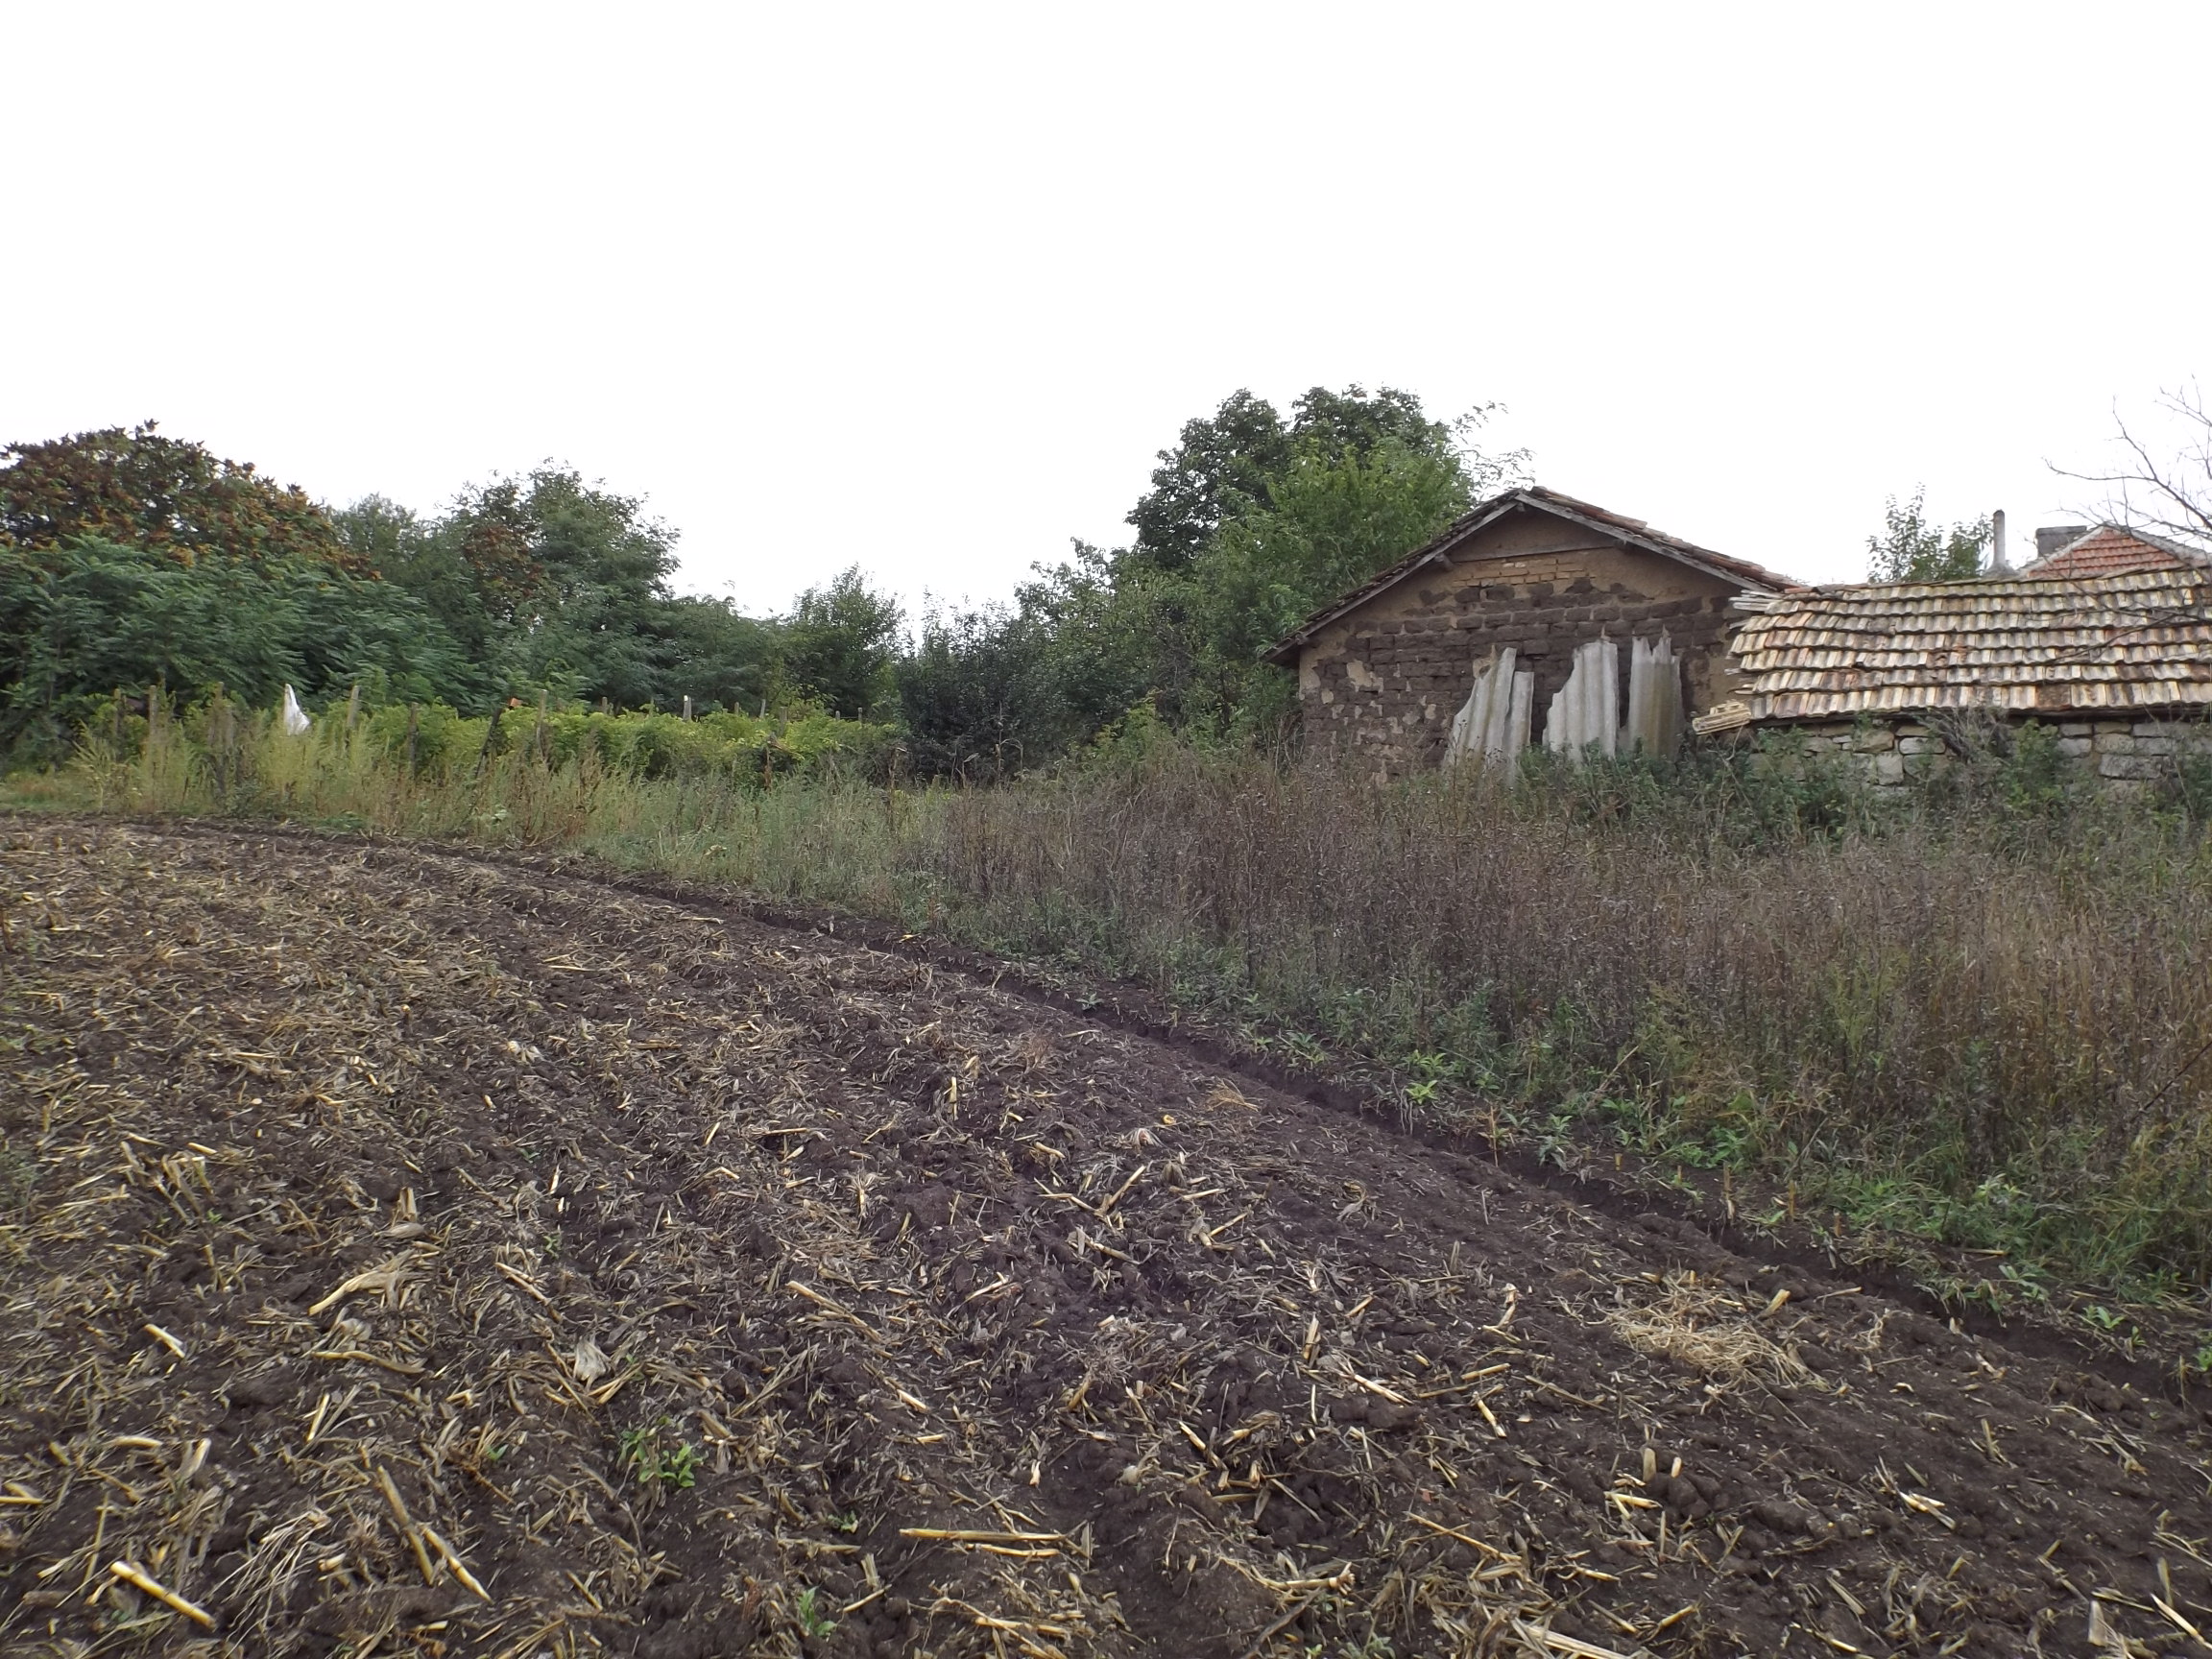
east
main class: Cropland
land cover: Maize
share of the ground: < 10 %
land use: Agriculture (excluding fallow land and kitchen gardens)
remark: Harvested field
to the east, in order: Maize; Artificial constructions in urban areas; Paved roads, cycling and walking lanes; Maize; Shrubland with sparse tree cover; Vineyards; Artificial constructions in urban areas
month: September
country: BG
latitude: 43.5631
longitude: 27.5270
